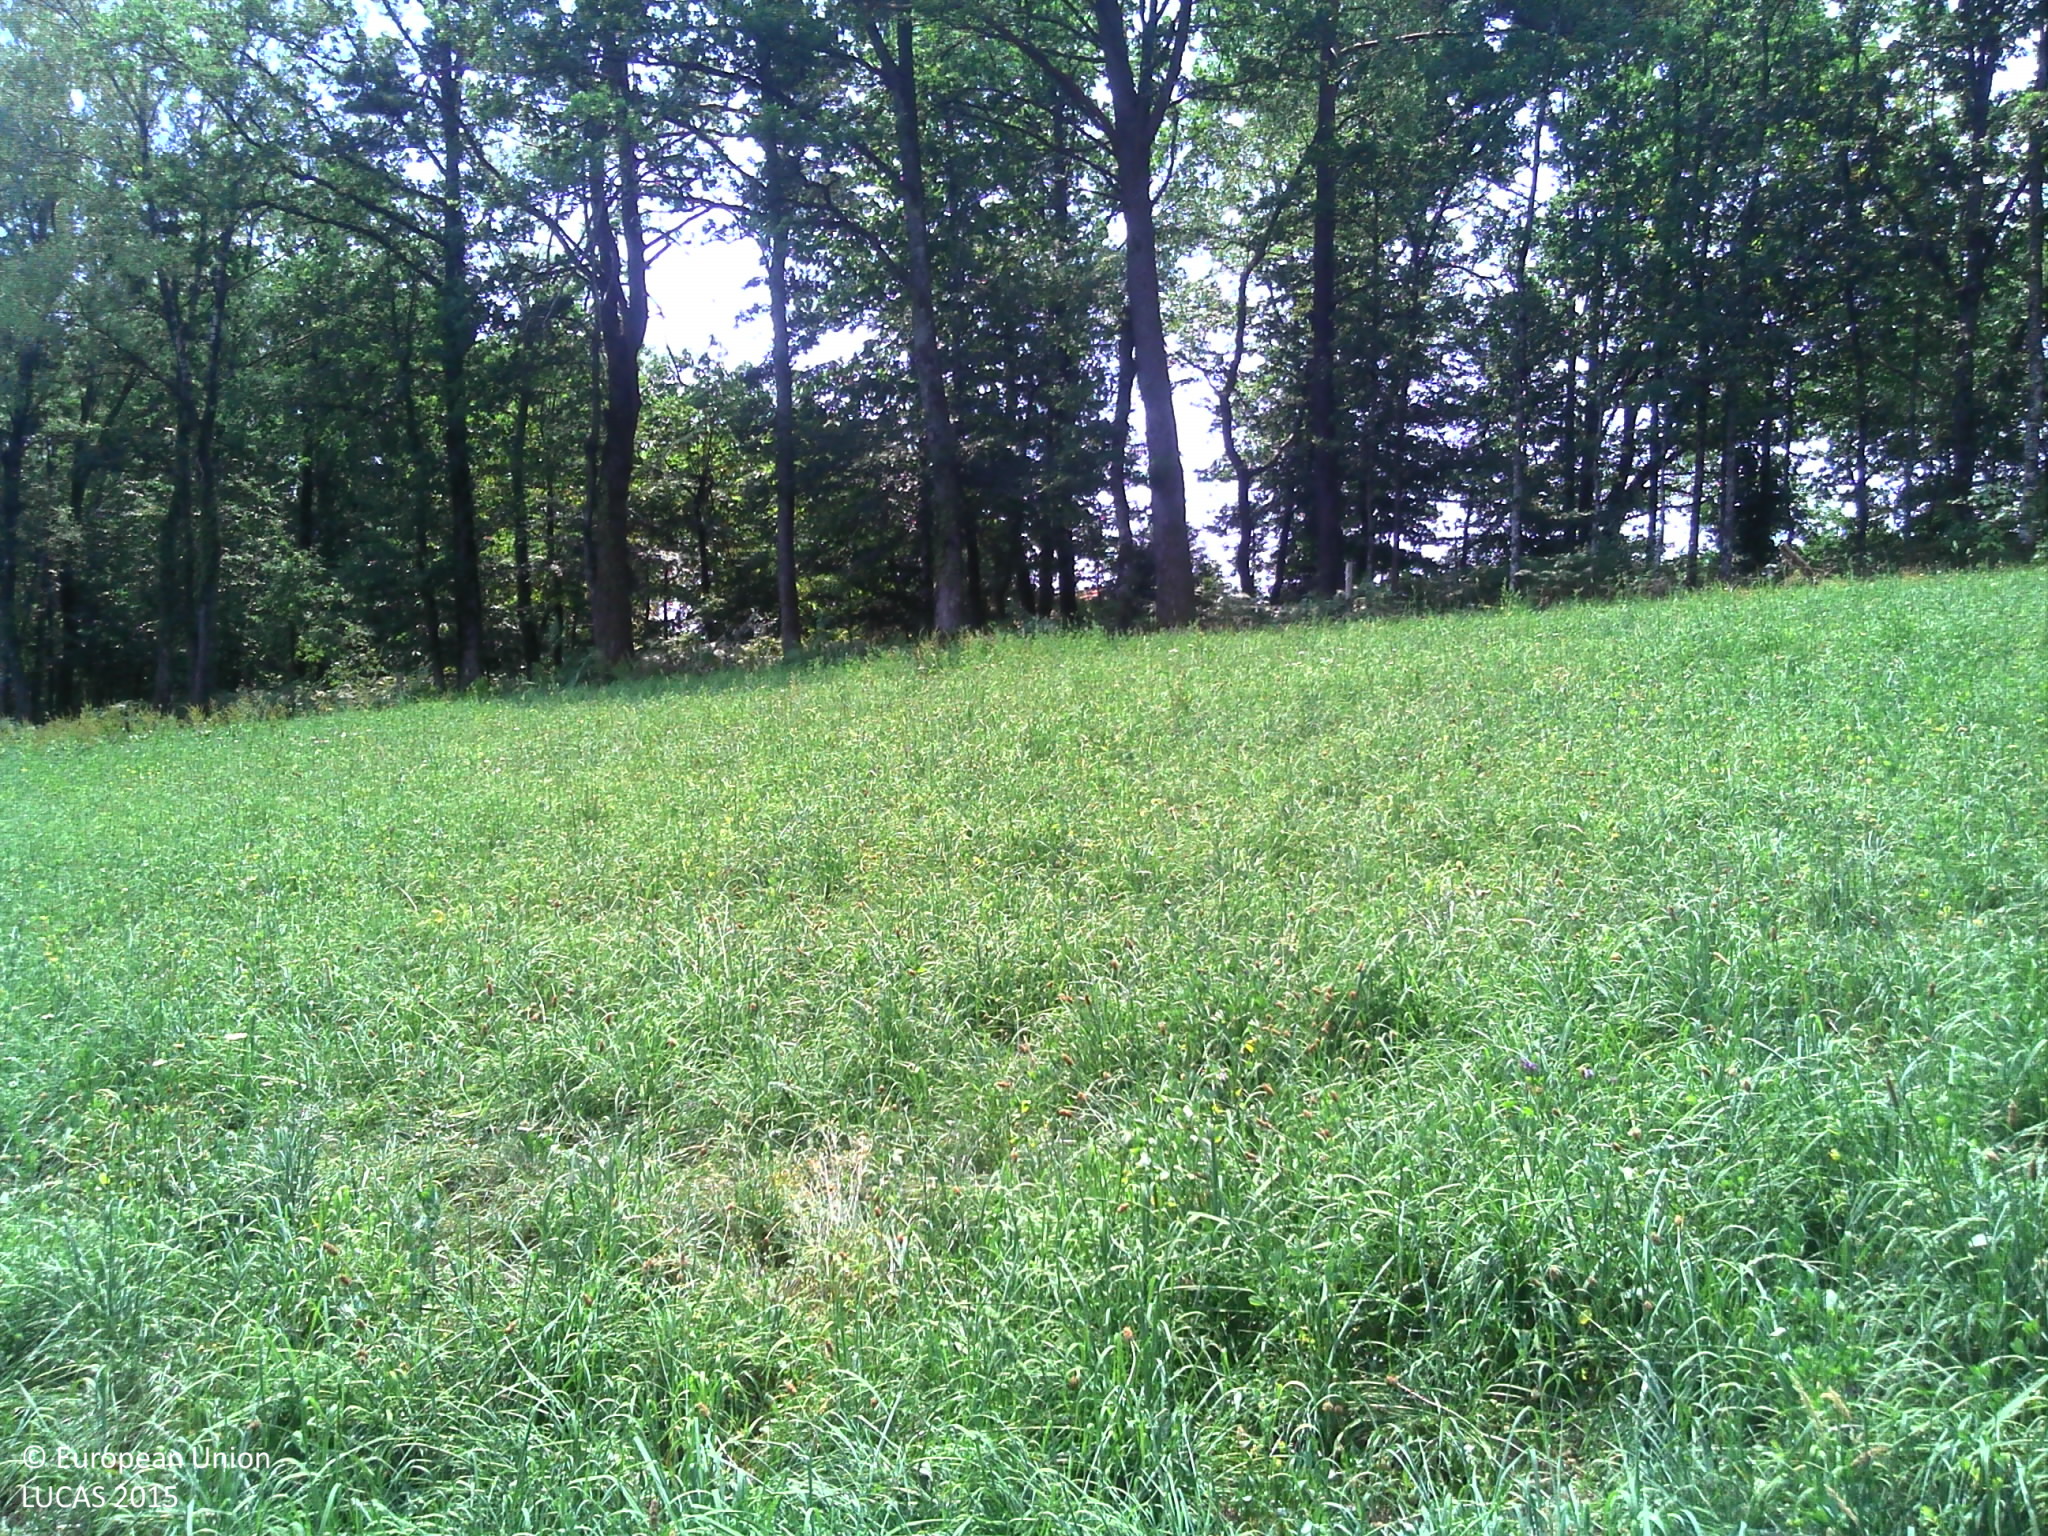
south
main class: Grassland
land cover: Grassland without tree/shrub cover
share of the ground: > 75 %
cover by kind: herbaceous plants 100 %
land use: Agriculture (excluding fallow land and kitchen gardens)
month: July
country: FR
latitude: 46.0172
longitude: 1.7913
